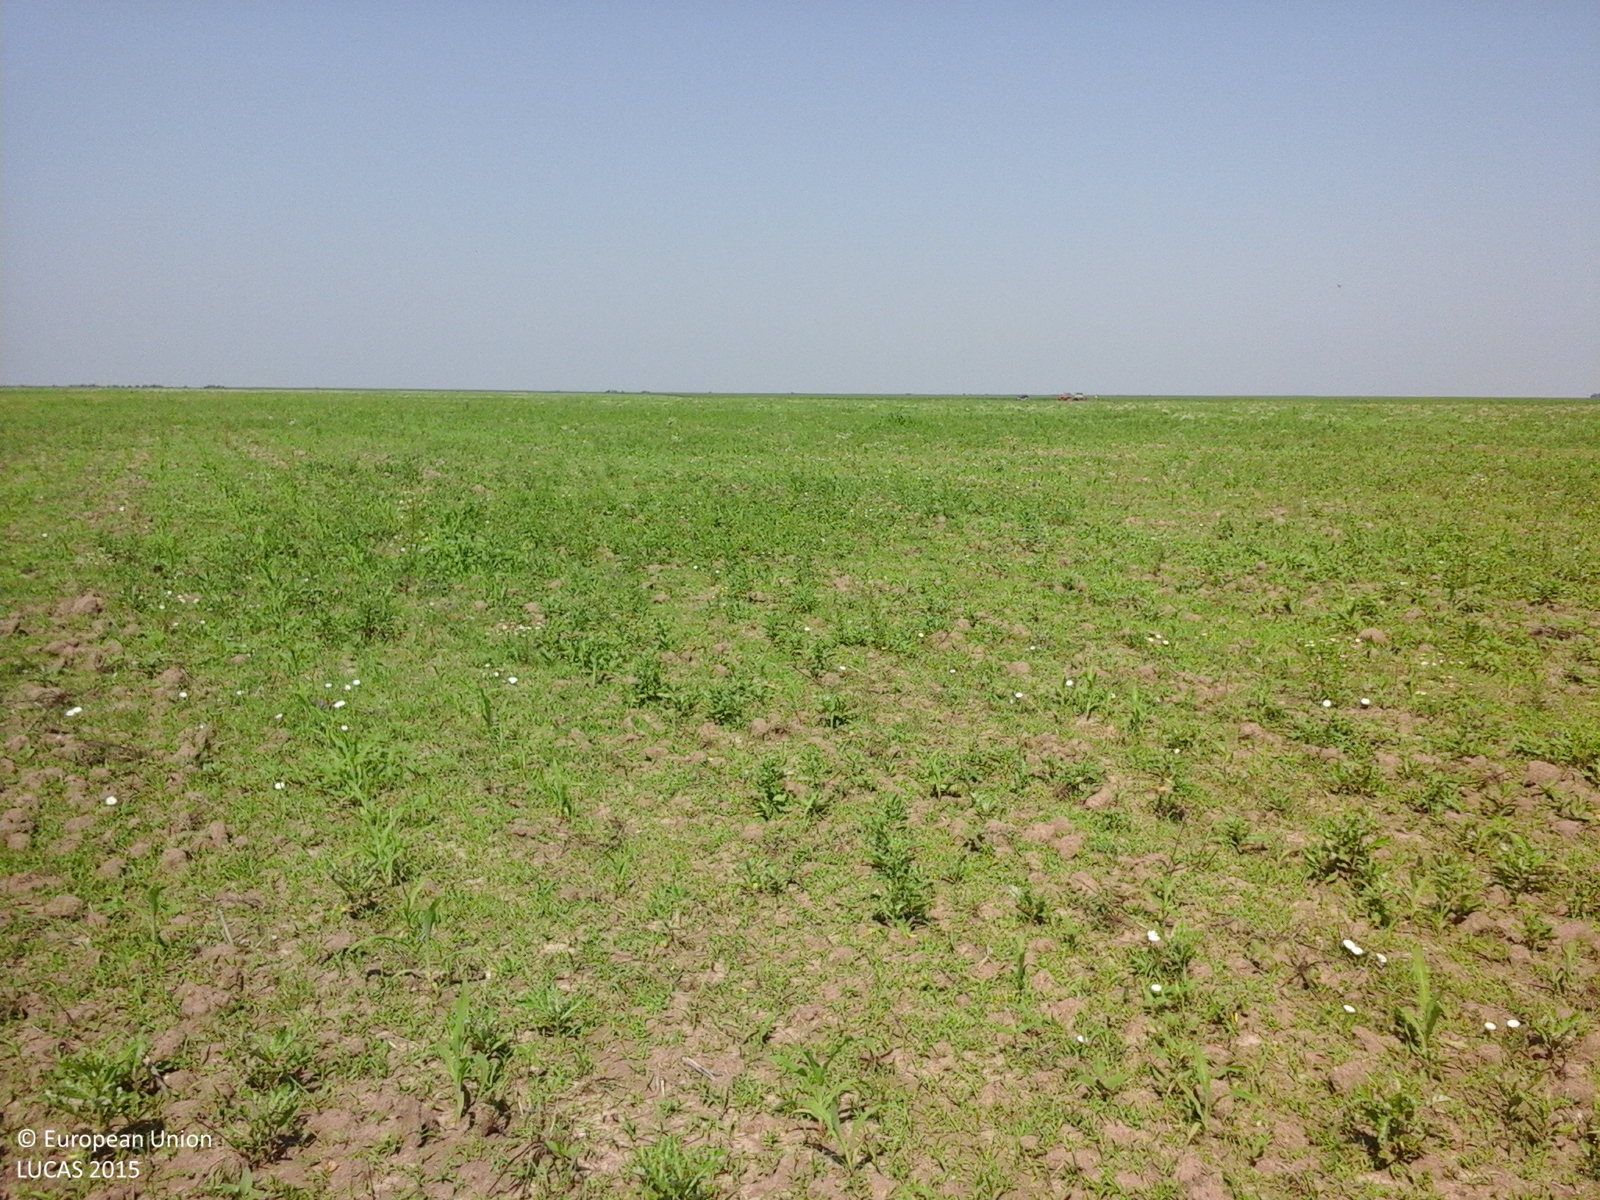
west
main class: Cropland
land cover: Maize
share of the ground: < 10 %
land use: Agriculture (excluding fallow land and kitchen gardens)
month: July
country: RO
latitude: 44.5292
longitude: 24.9152
